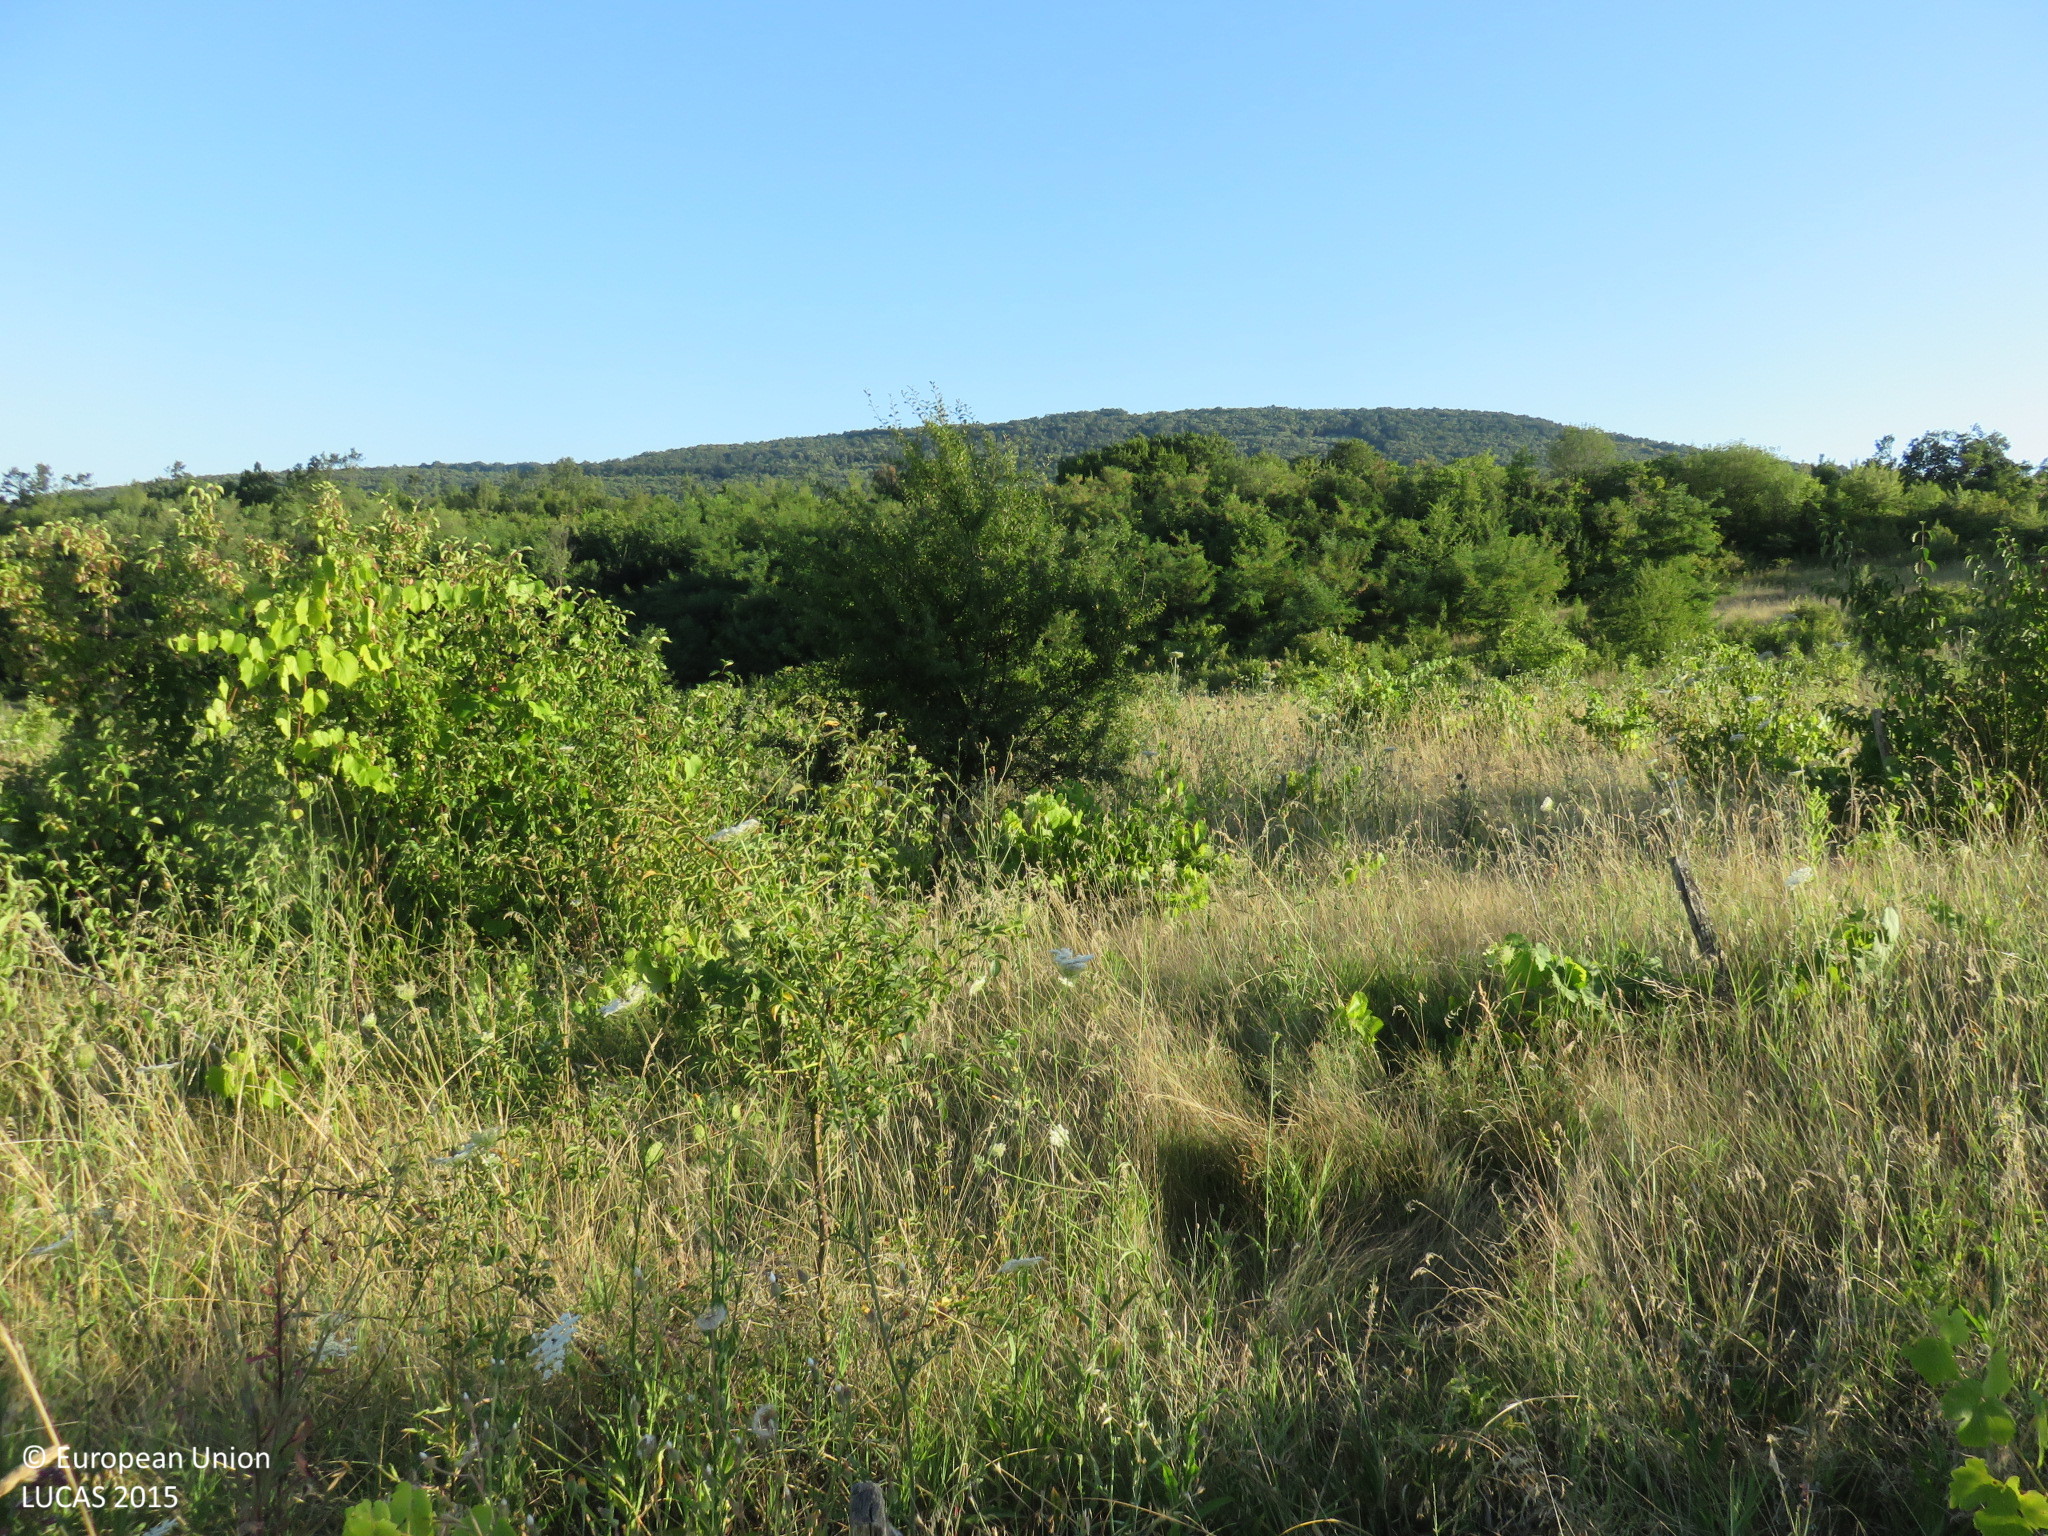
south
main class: Cropland
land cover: Vineyards
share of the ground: 10 - 25 %
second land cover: Spontaneously vegetated surfaces
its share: > 75 %
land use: Abandoned areas
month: July
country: BG
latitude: 43.1380
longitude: 25.1555
